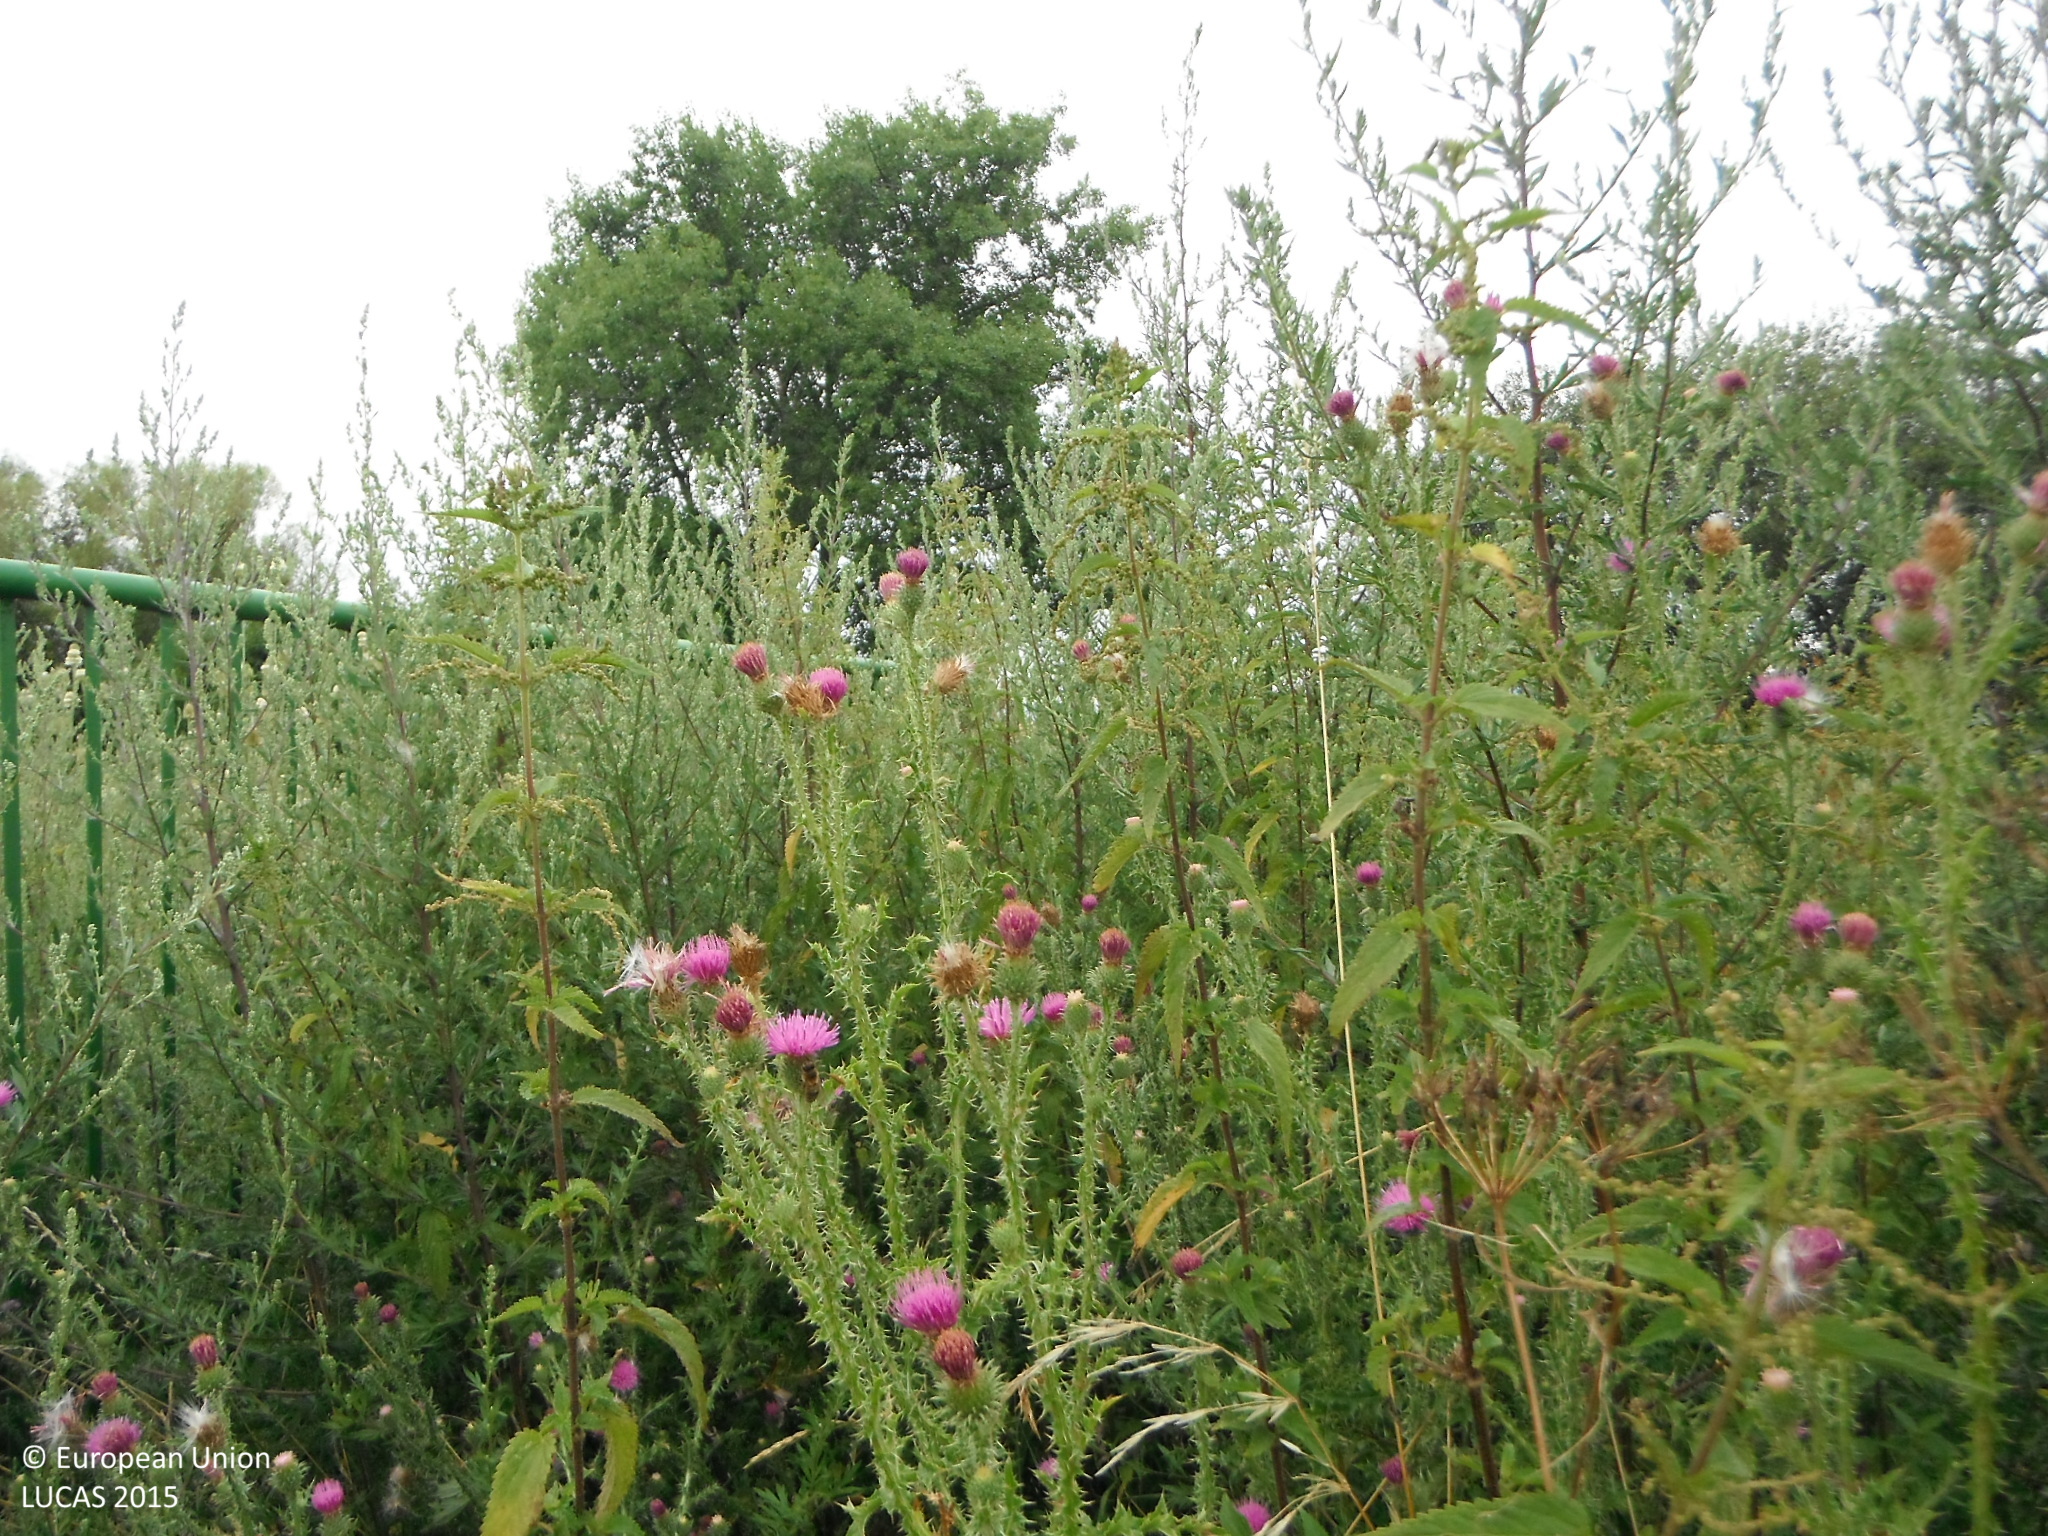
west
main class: Cropland
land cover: Maize
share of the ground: > 75 %
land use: Agriculture (excluding fallow land and kitchen gardens)
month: July
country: SK
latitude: 48.6709
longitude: 18.2856
